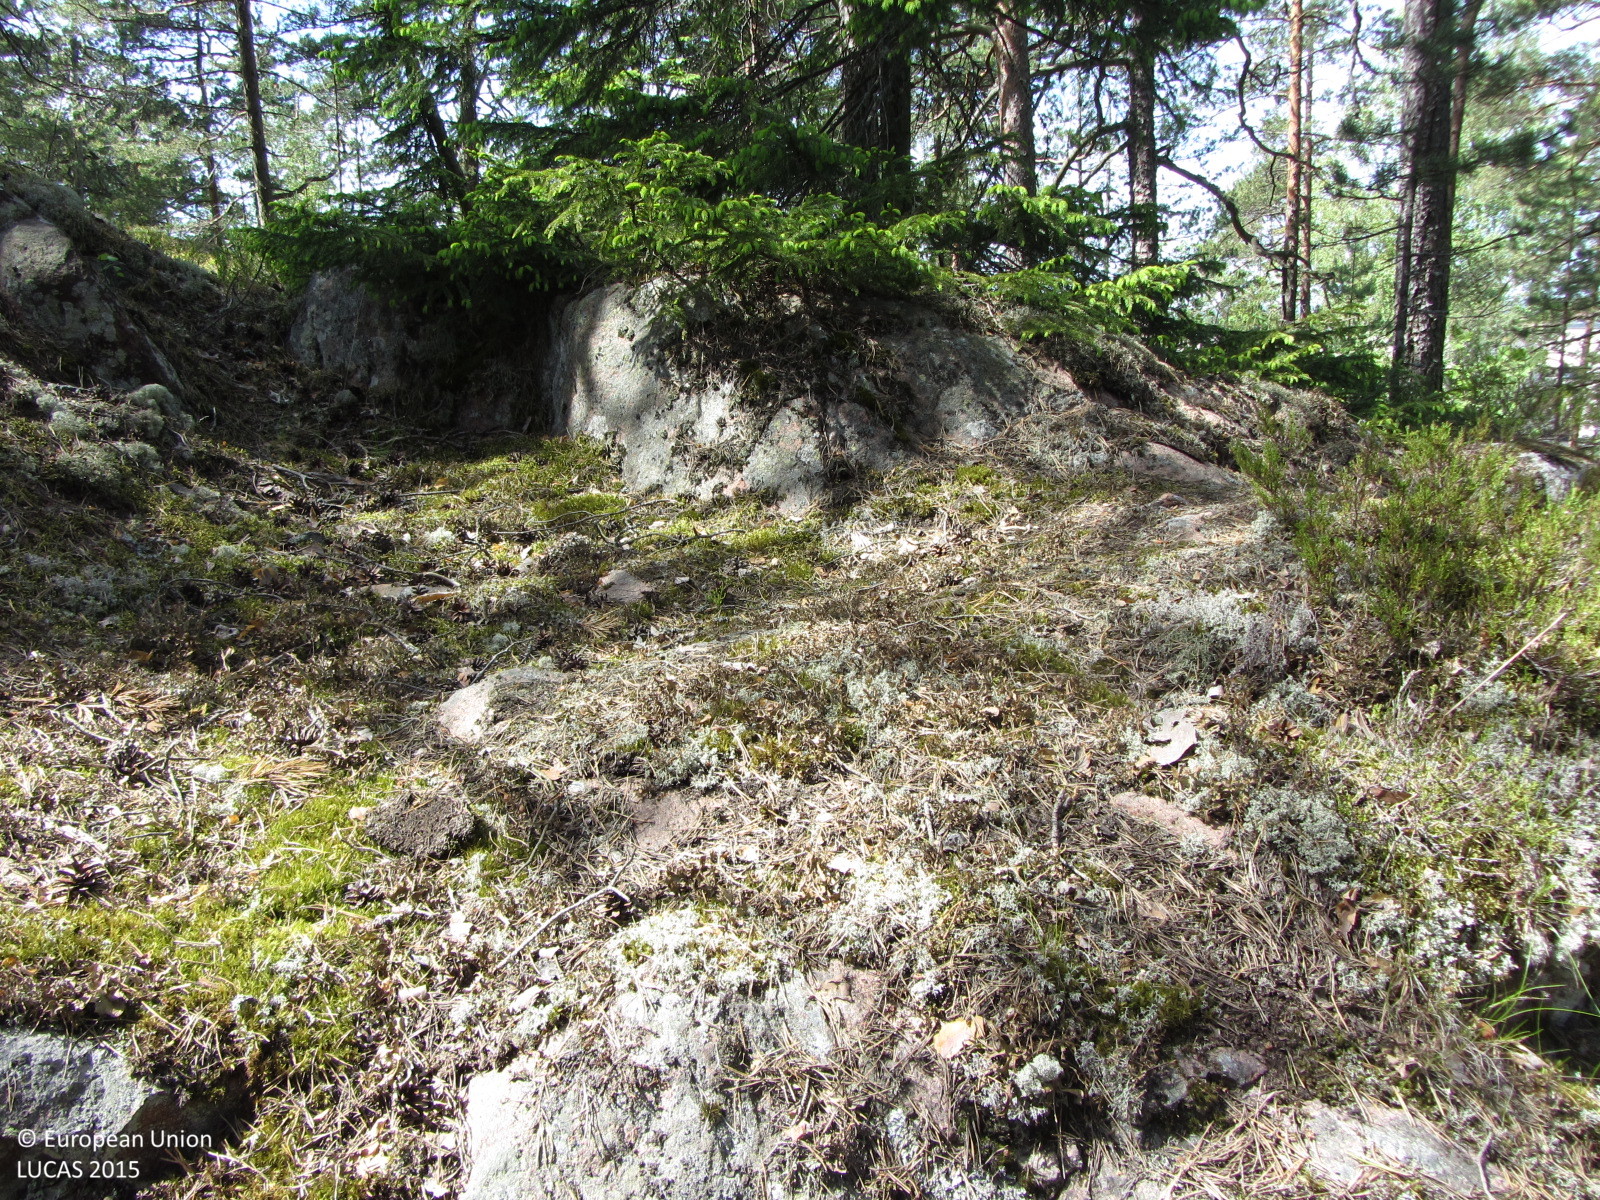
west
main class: Woodland
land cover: Pine dominated coniferous woodland
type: boreal forest
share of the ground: > 75 %
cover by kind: coniferous forest trees 70 %, shrubs 10 %, consolidated bare surface 10 %, broadleaved forest trees 5 %, lichens and mosses 5 %
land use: Forestry
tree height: > 5 m
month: June
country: FI
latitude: 60.1658
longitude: 24.6177
